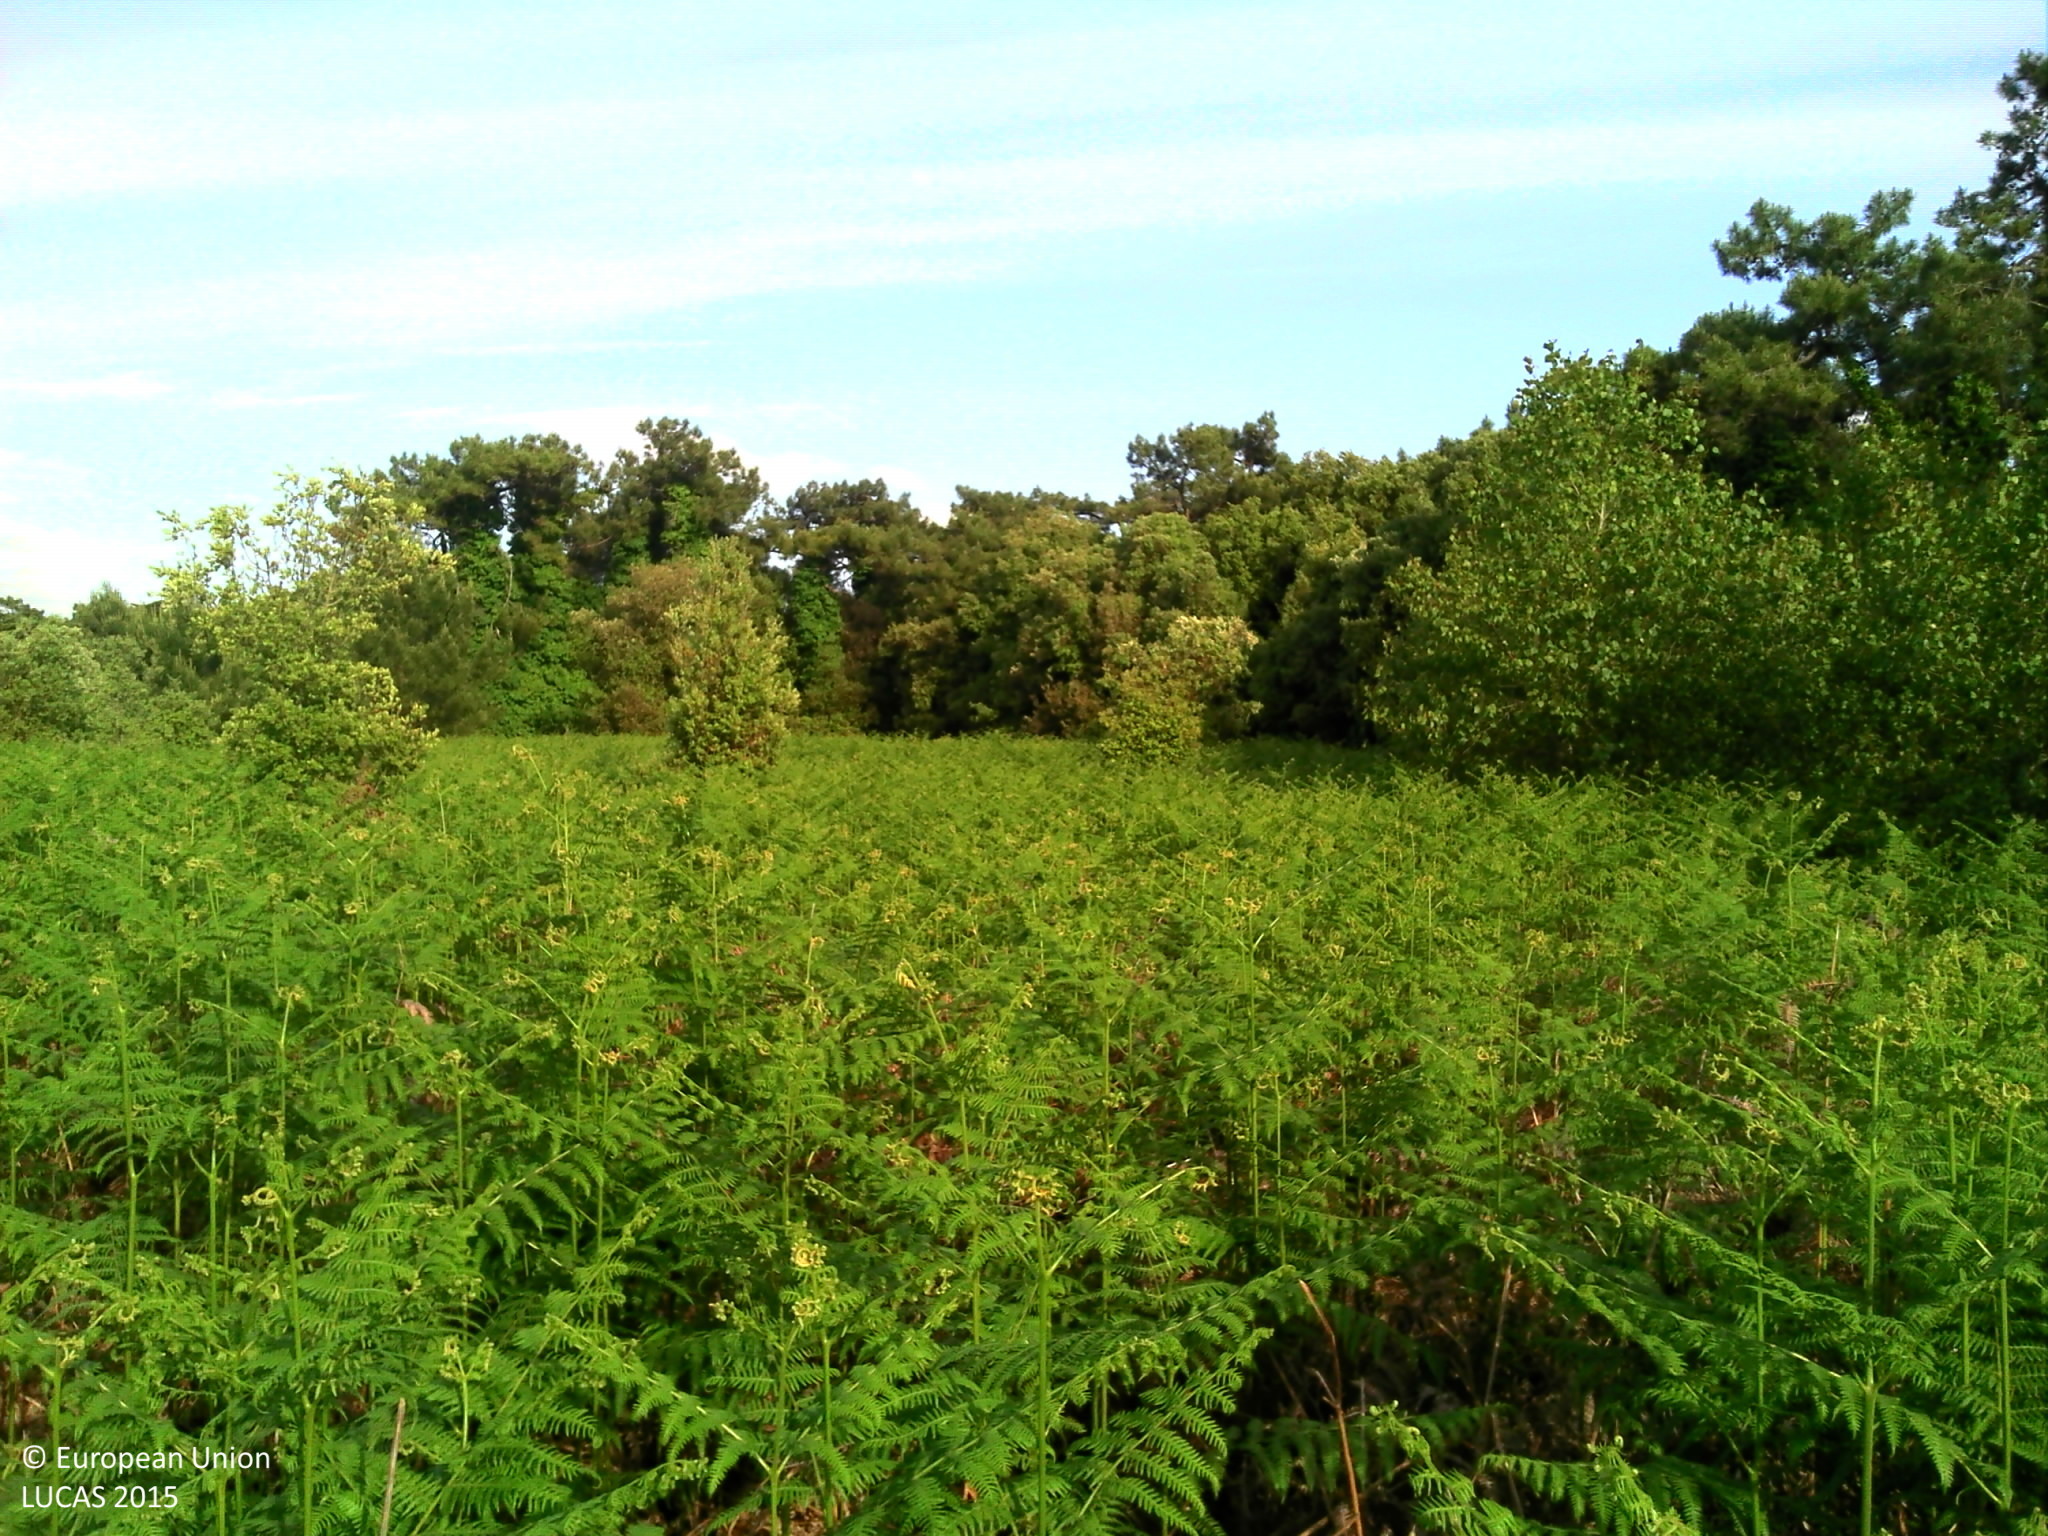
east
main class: Grassland
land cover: Spontaneously vegetated surfaces
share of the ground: > 75 %
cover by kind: herbaceous plants 95 %, shrubs 5 %
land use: Semi-natural and natural areas not in use
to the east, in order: Spontaneously vegetated surfaces; Sand; Spontaneously vegetated surfaces; Sand; Tracks; Spontaneously vegetated surfaces; Tracks
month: May
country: FR
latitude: 46.1669
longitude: -1.3145
